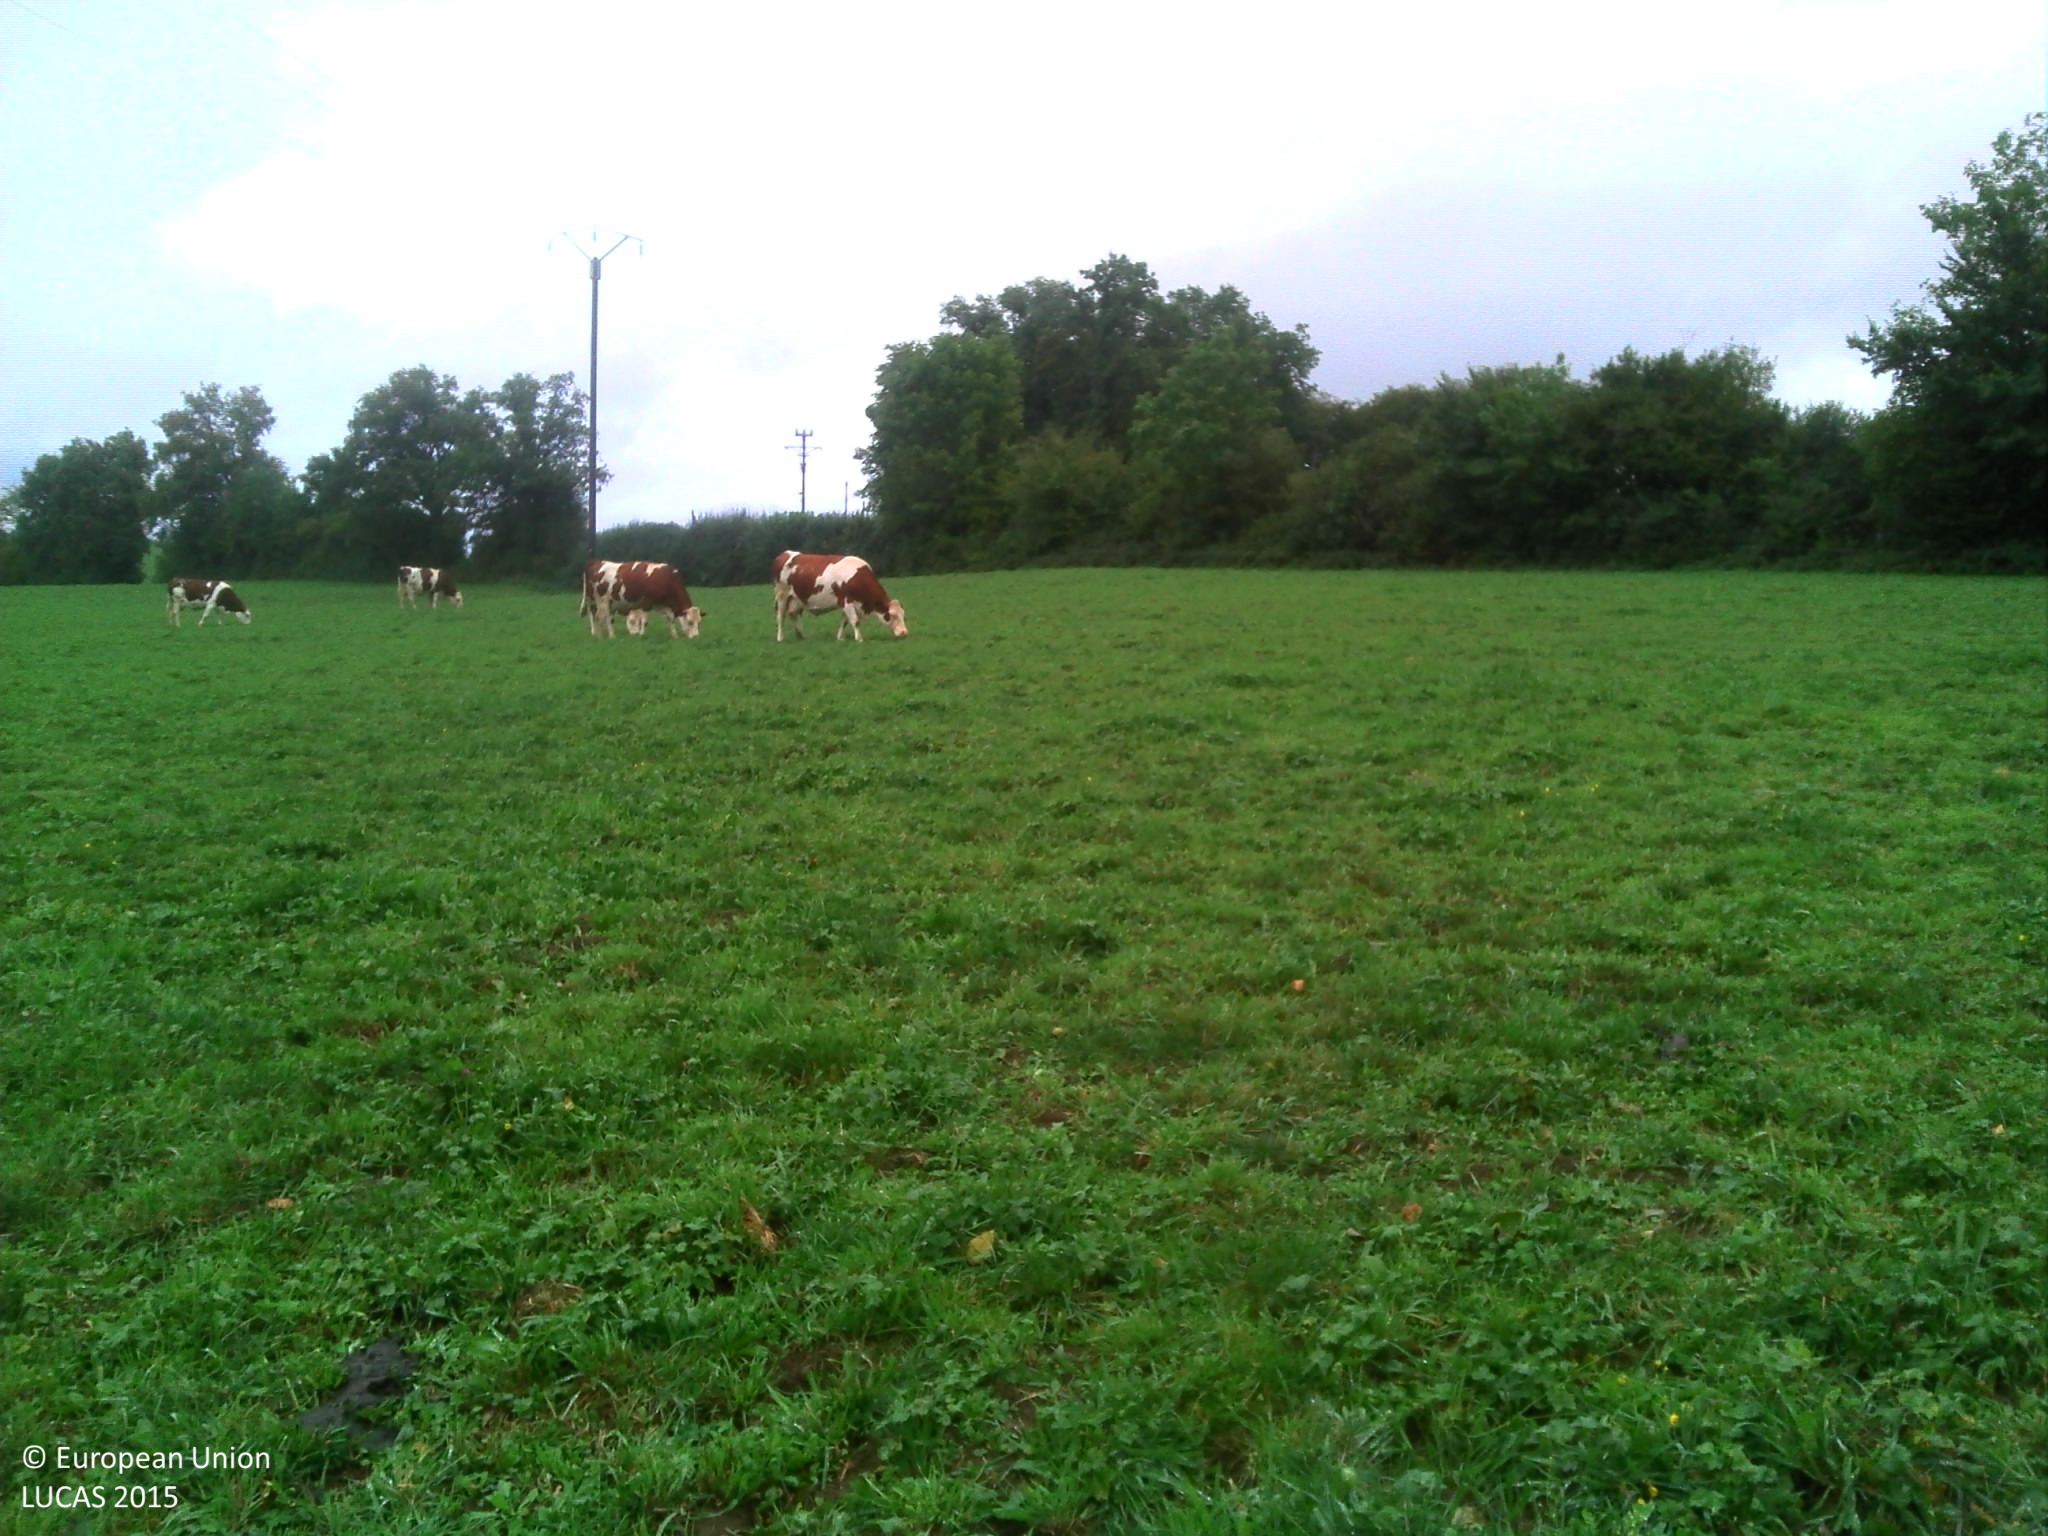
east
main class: Grassland
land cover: Grassland without tree/shrub cover
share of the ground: > 75 %
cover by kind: herbaceous plants 95 %, unconsolidated bare surface 5 %
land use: Agriculture (excluding fallow land and kitchen gardens)
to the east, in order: Grassland without tree/shrub cover; Fences; Broadleaved woodland; Grass margins; Paved roads, cycling and walking lanes; Grass margins; Ditches and canals; Fences; Electric lines; Grassland without tree/shrub cover; Broadleaved woodland; Grassland without tree/shrub cover; Artificial constructions in urban areas
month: September
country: FR
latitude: 47.1505
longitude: 6.2434
